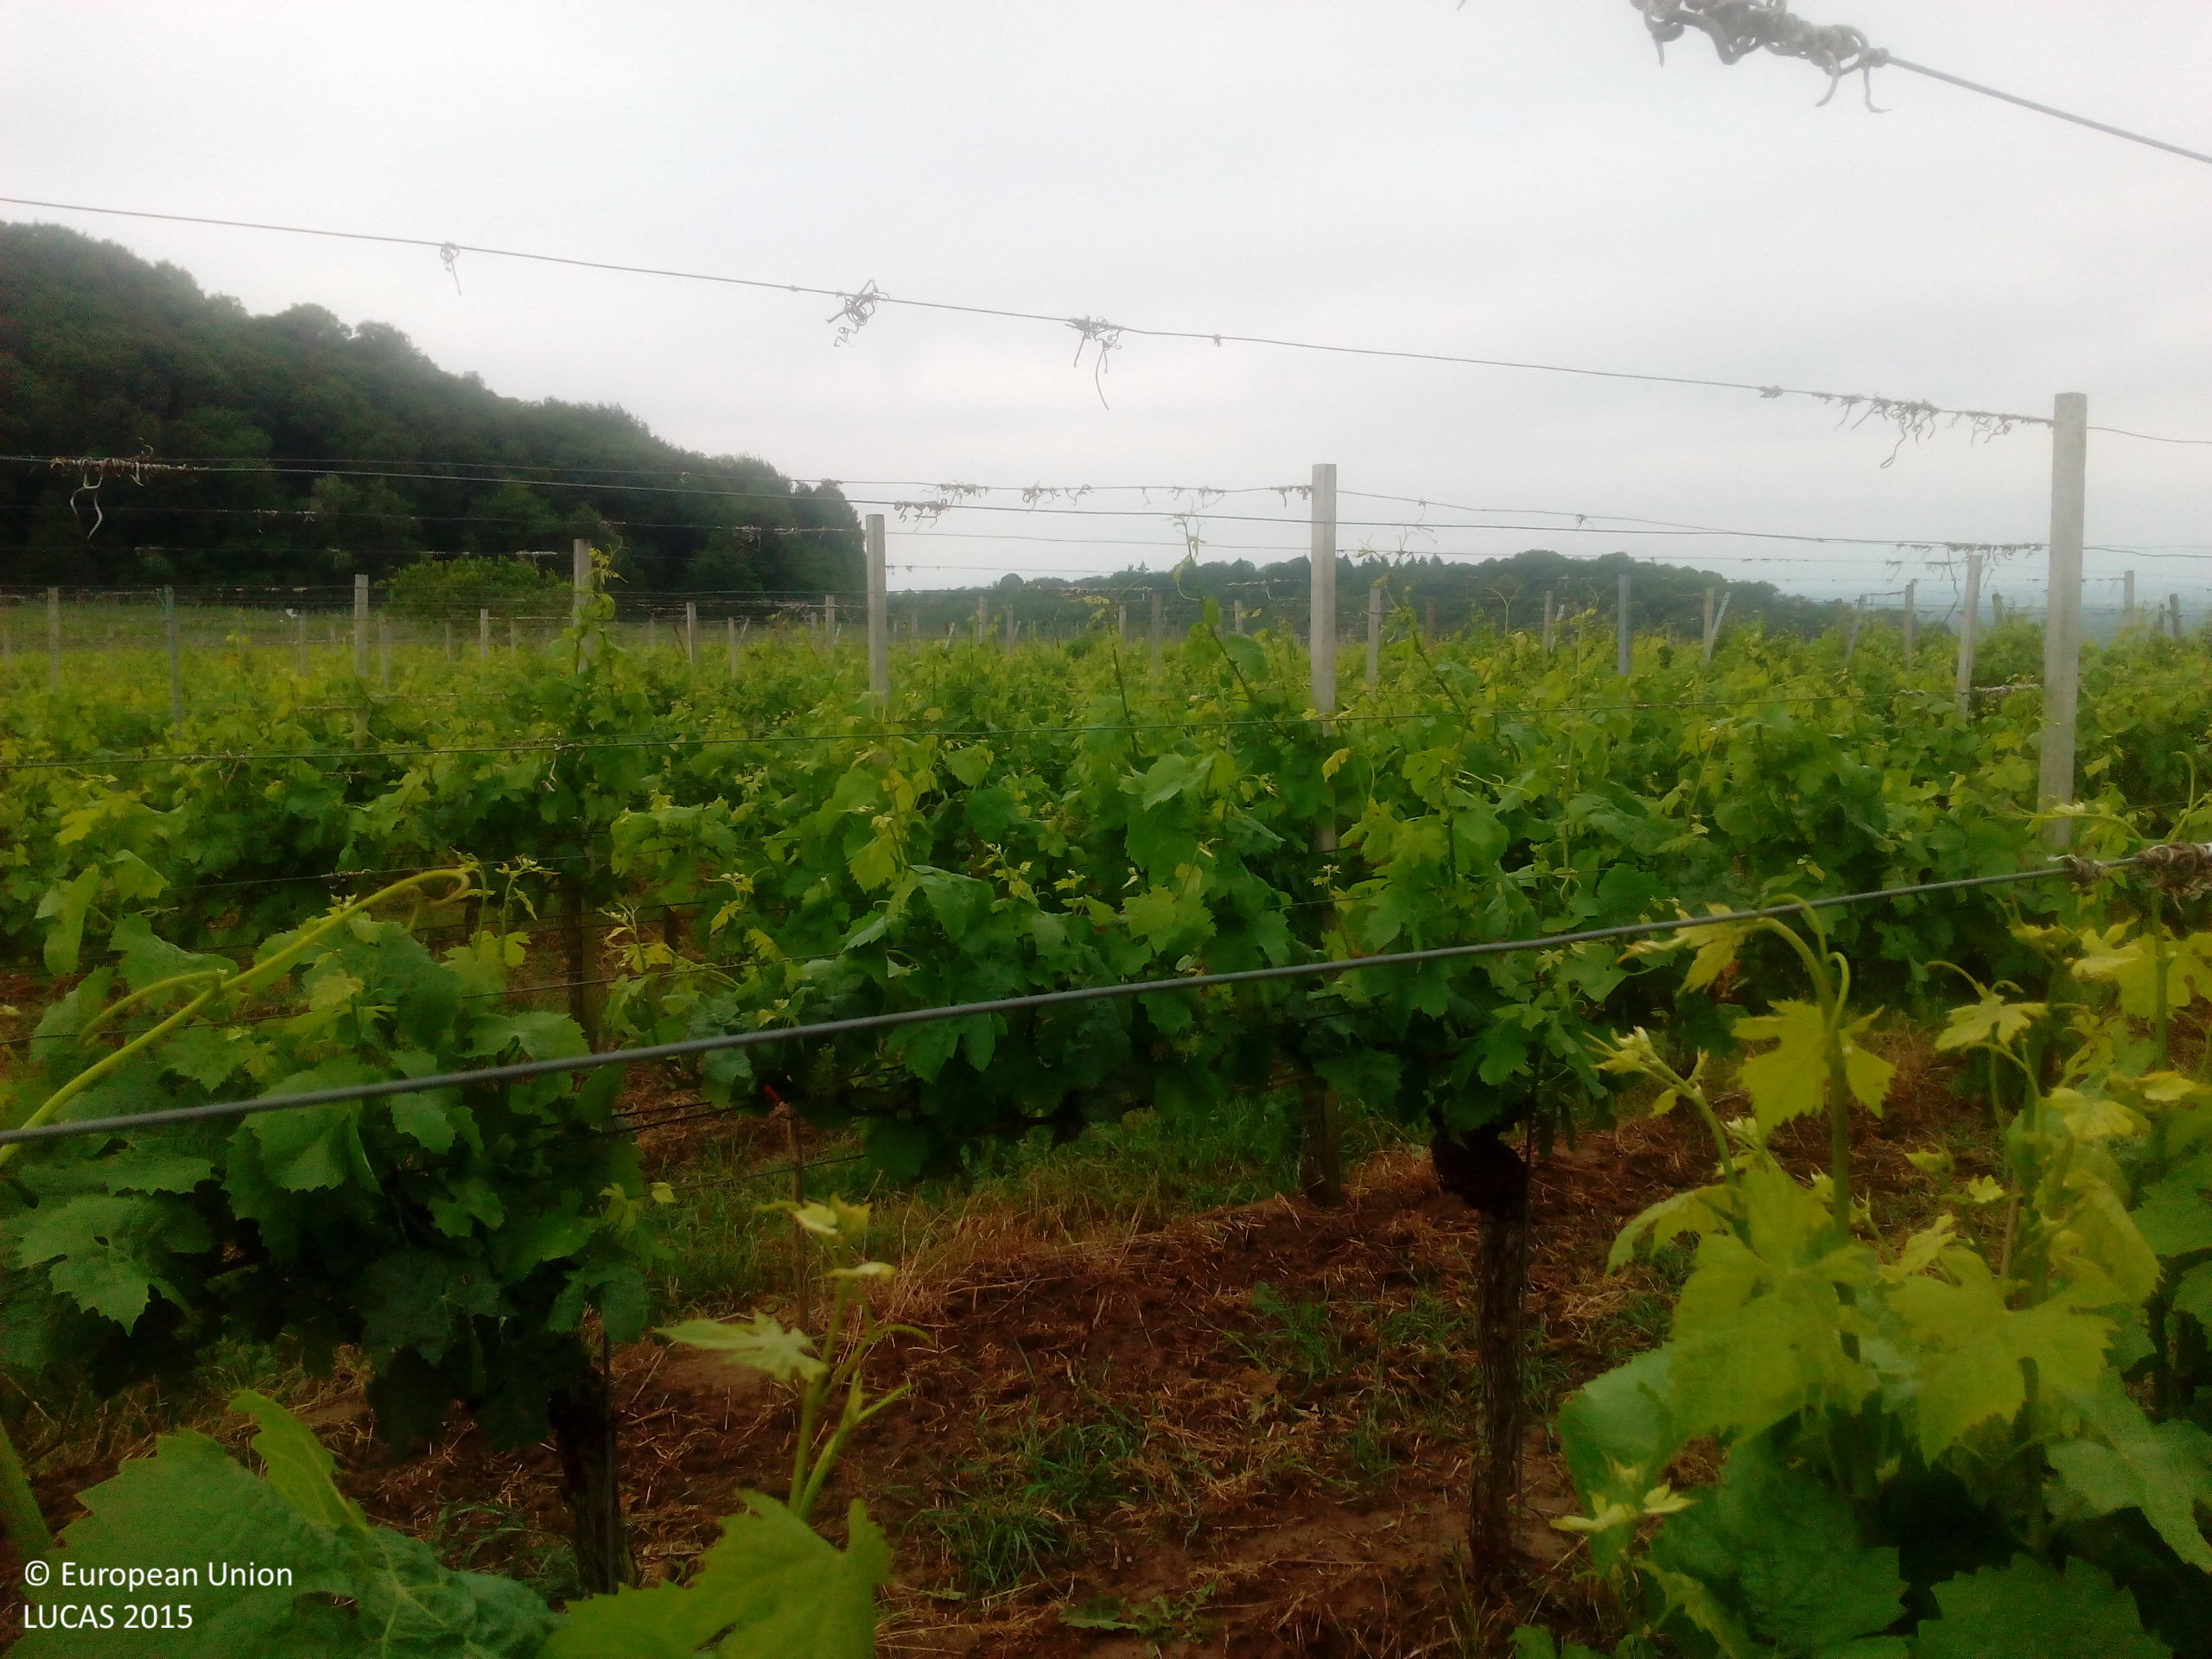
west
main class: Cropland
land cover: Vineyards
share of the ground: 50 - 75 %
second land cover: Grassland without tree/shrub cover
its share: 25 - 50 %
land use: Agriculture (excluding fallow land and kitchen gardens)
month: June
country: DE
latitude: 48.0720
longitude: 7.6256
